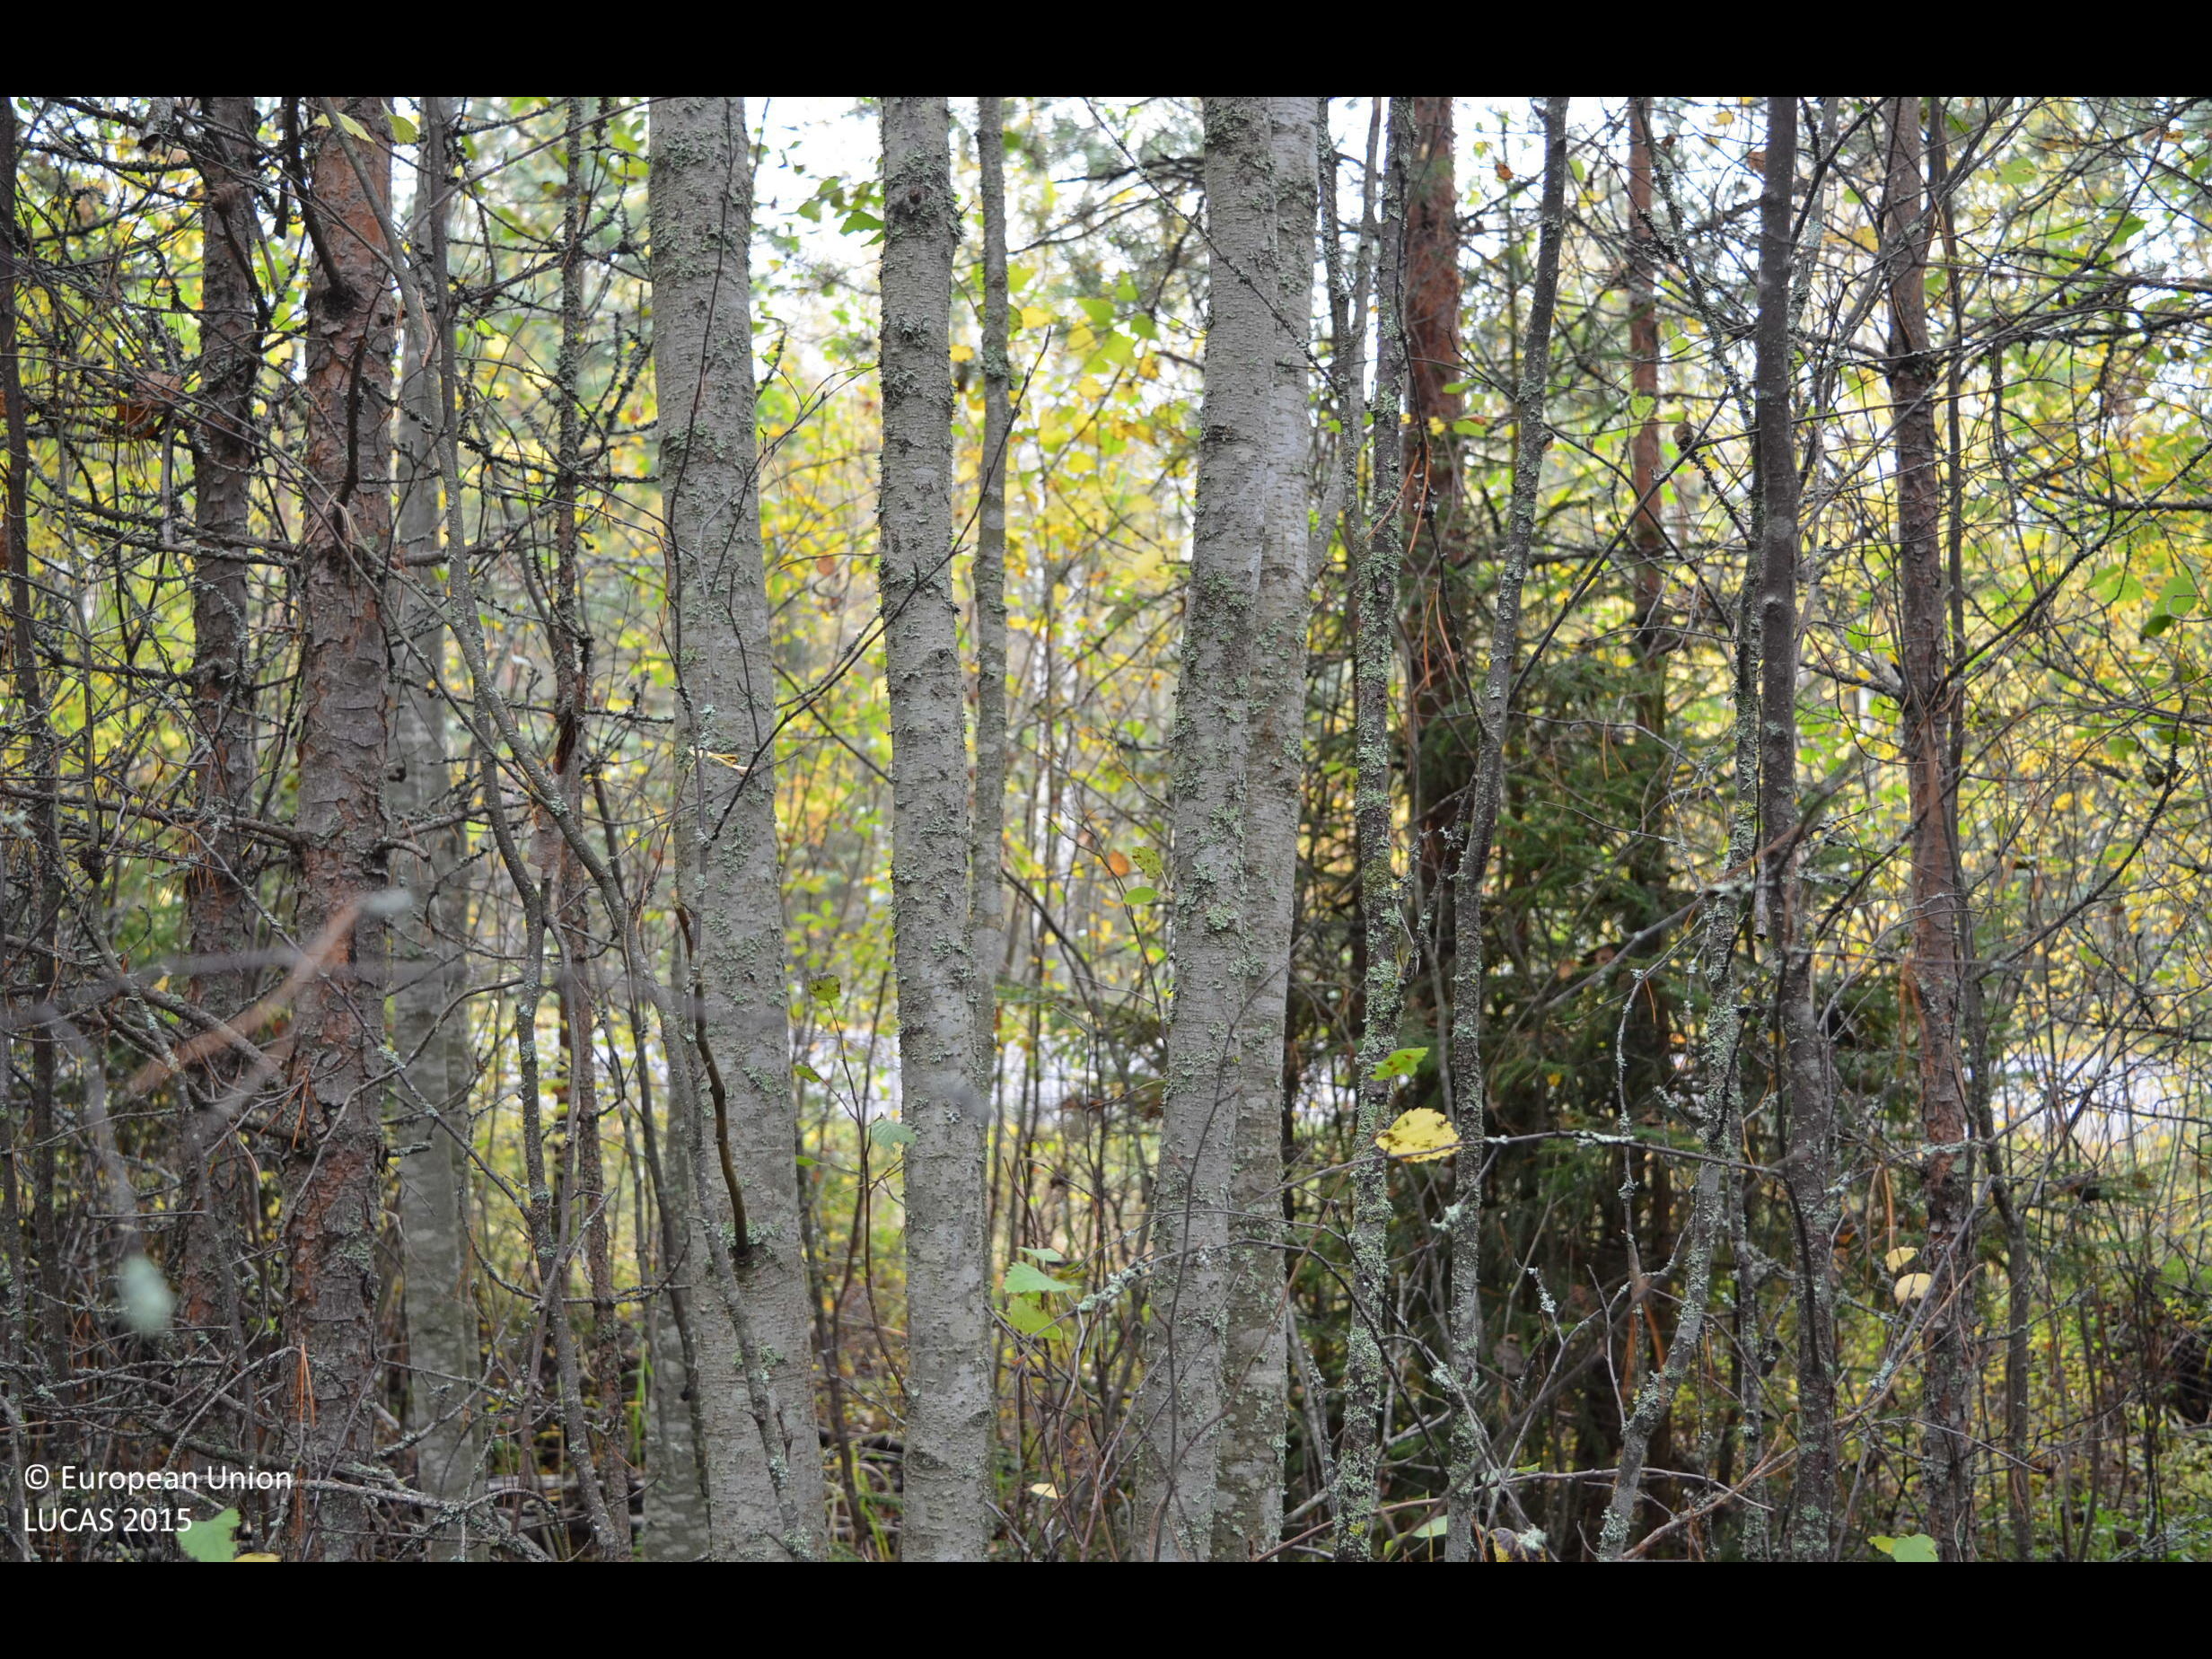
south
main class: Woodland
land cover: Pine dominated mixed woodland
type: boreal forest
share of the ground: > 75 %
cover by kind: broadleaved forest trees 50 %, coniferous forest trees 40 %, shrubs 5 %, lichens and mosses 5 %
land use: Forestry
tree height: > 5 m
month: September
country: FI
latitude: 62.5365
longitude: 23.6595
